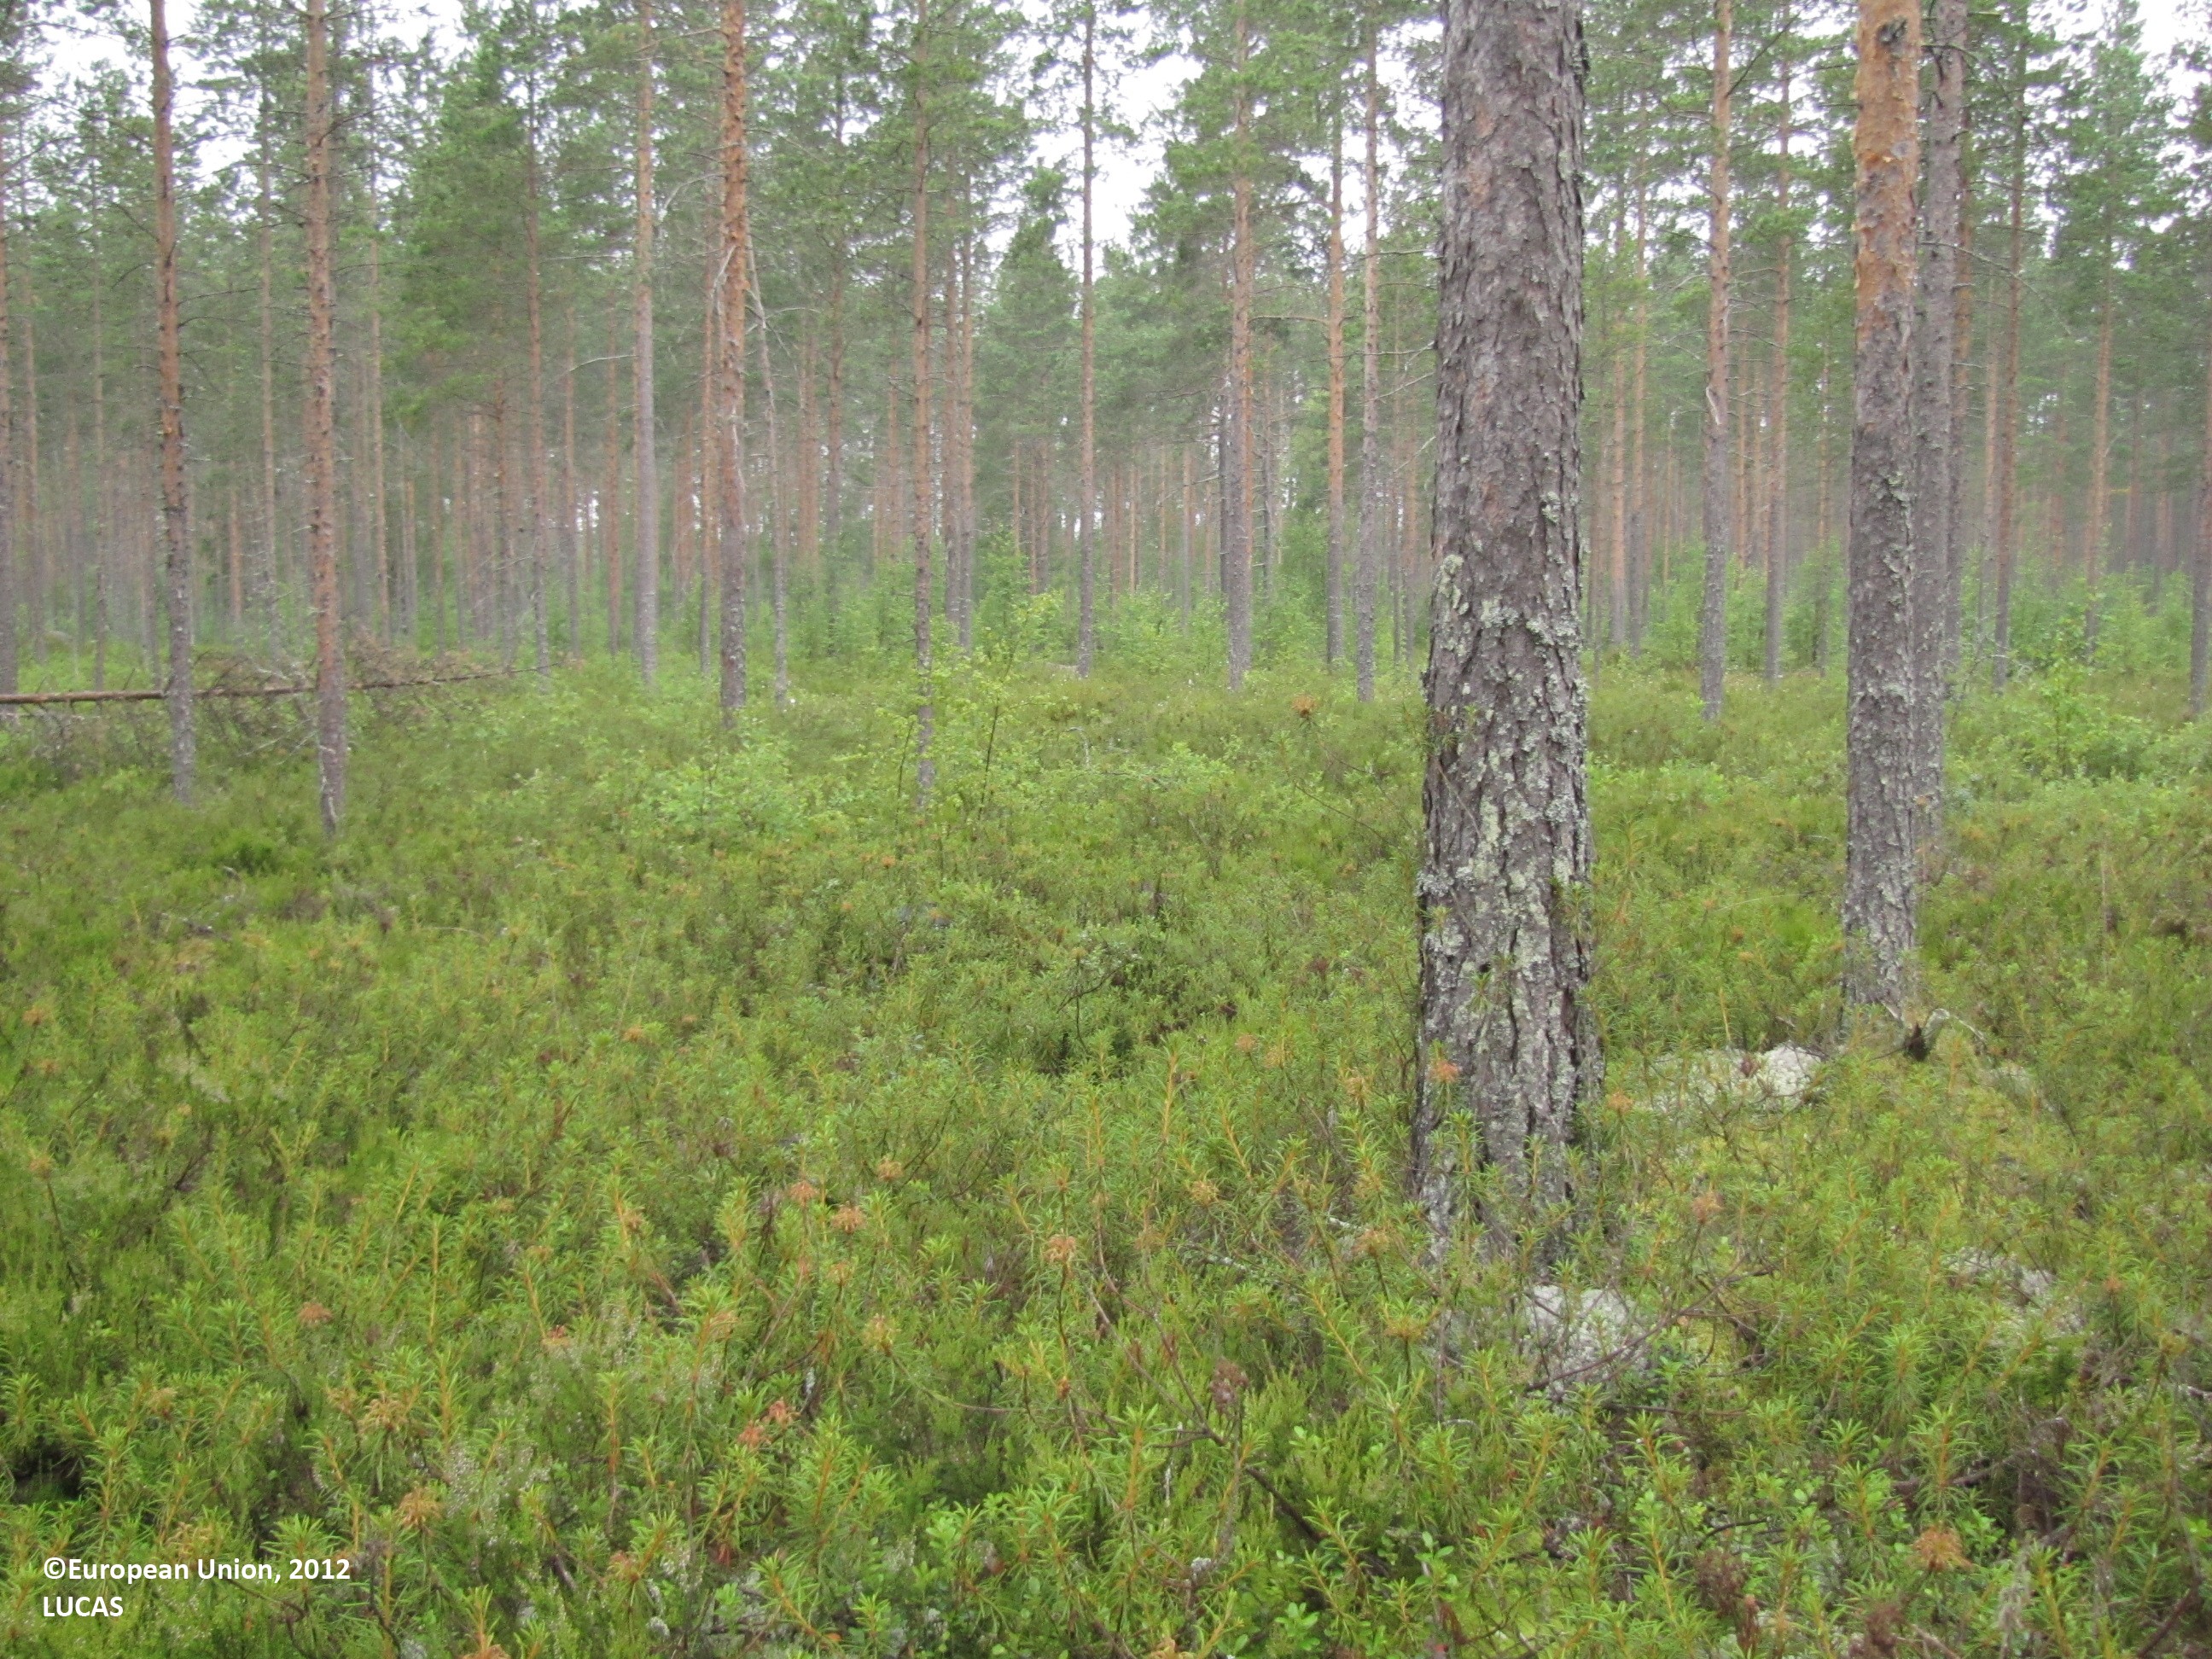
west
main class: Woodland
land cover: Pine dominated coniferous woodland
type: boreal forest
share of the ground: 50 - 75 %
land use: Forestry
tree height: > 5 m
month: July
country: FI
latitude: 62.0866
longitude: 22.9524
